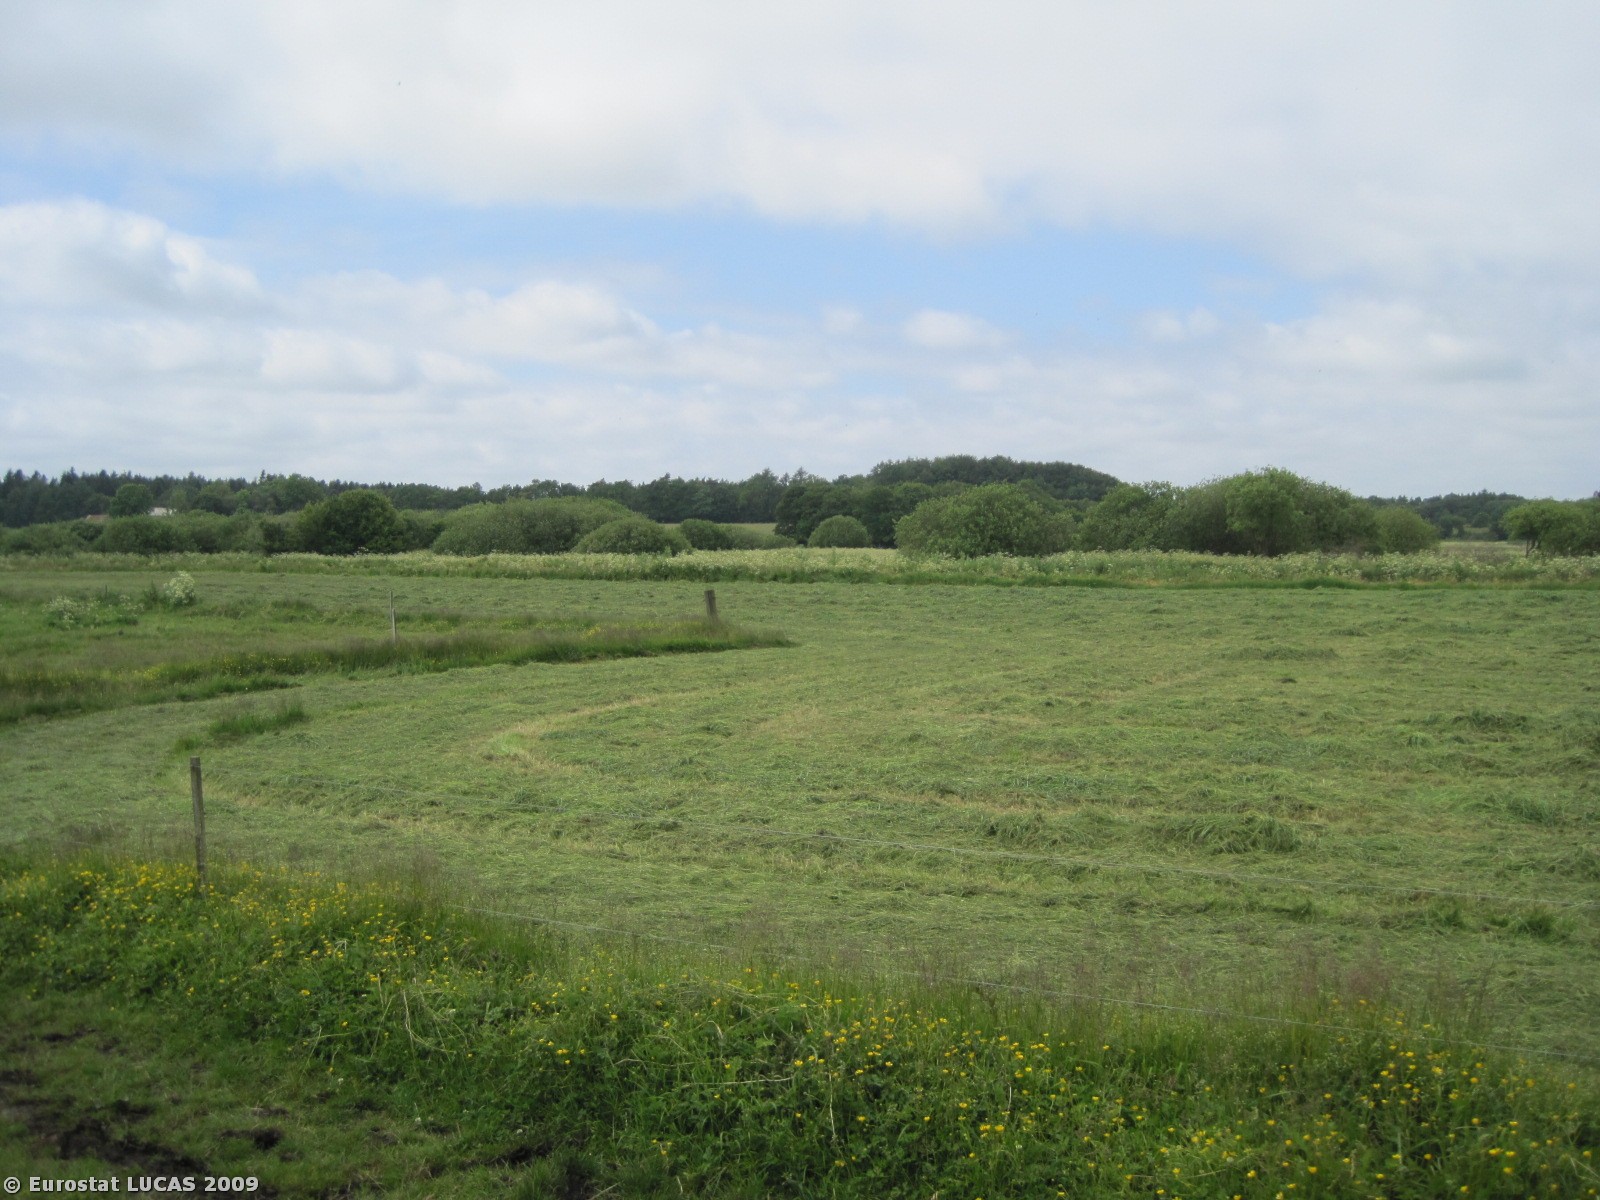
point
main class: Grassland
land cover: Grassland without tree/shrub cover
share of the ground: > 75 %
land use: Agriculture (excluding fallow land and kitchen gardens)
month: June
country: DK
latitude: 57.2483
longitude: 10.1489
